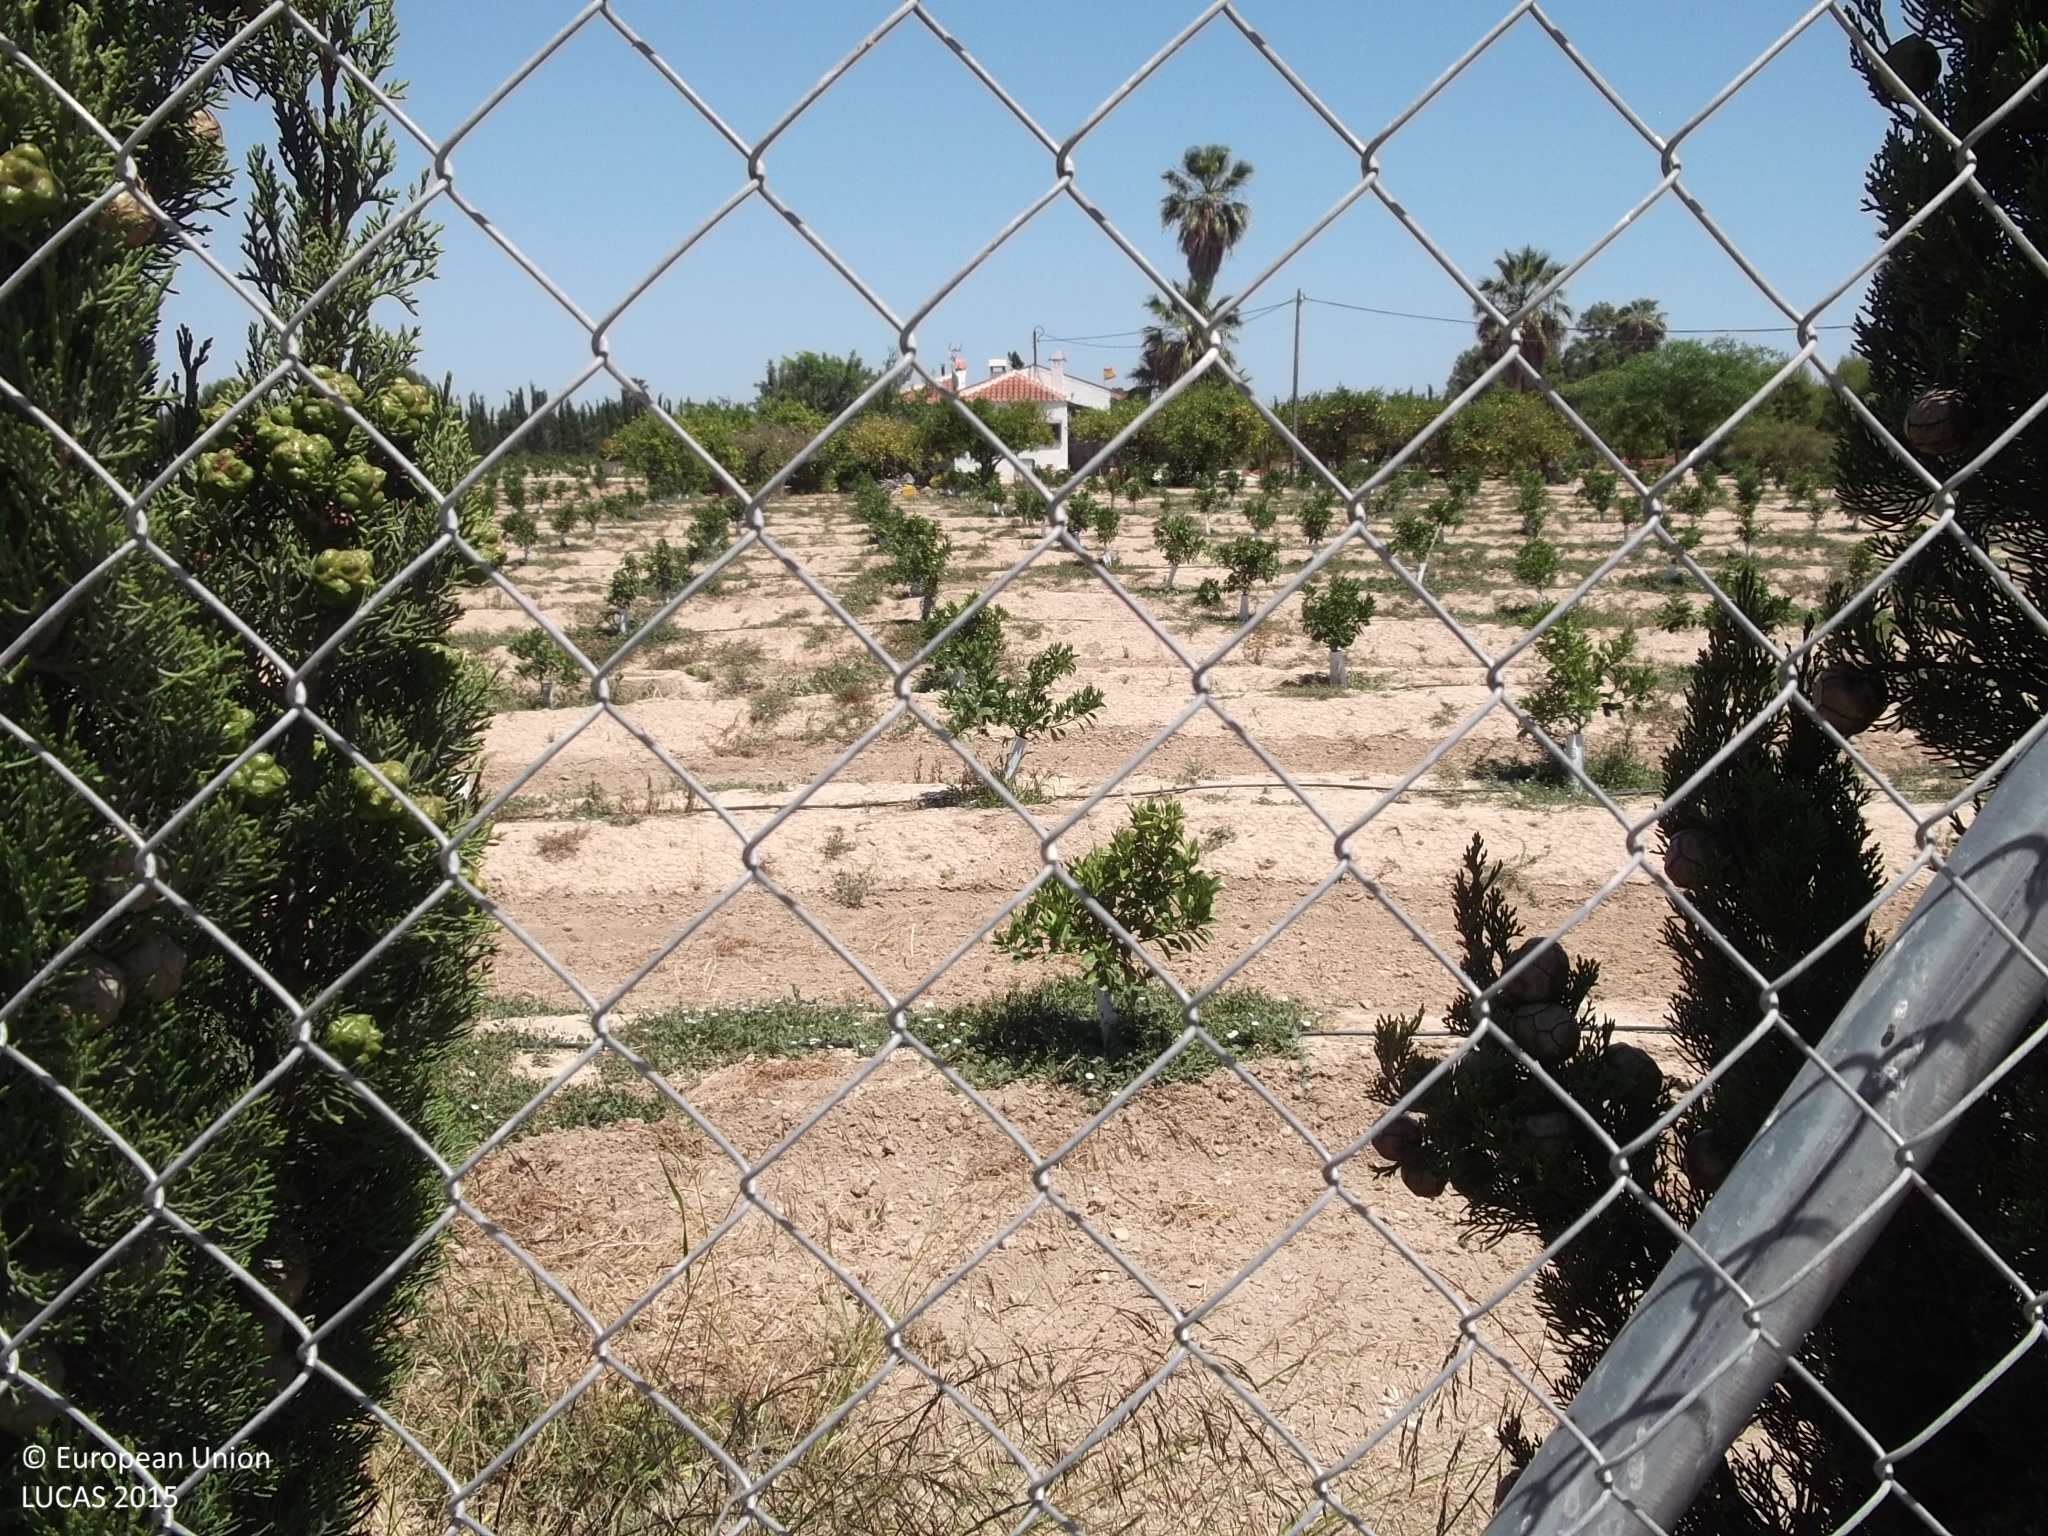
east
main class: Cropland
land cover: Oranges
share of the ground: < 10 %
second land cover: Spontaneously vegetated surfaces
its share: 25 - 50 %
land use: Agriculture (excluding fallow land and kitchen gardens)
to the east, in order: Oranges; Spontaneously vegetated surfaces; Permanent crops (only in case pi); Tracks; Permanent crops (only in case pi); Tracks; Permanent crops (only in case pi)
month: May
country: ES
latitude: 38.0962
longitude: -0.8280
